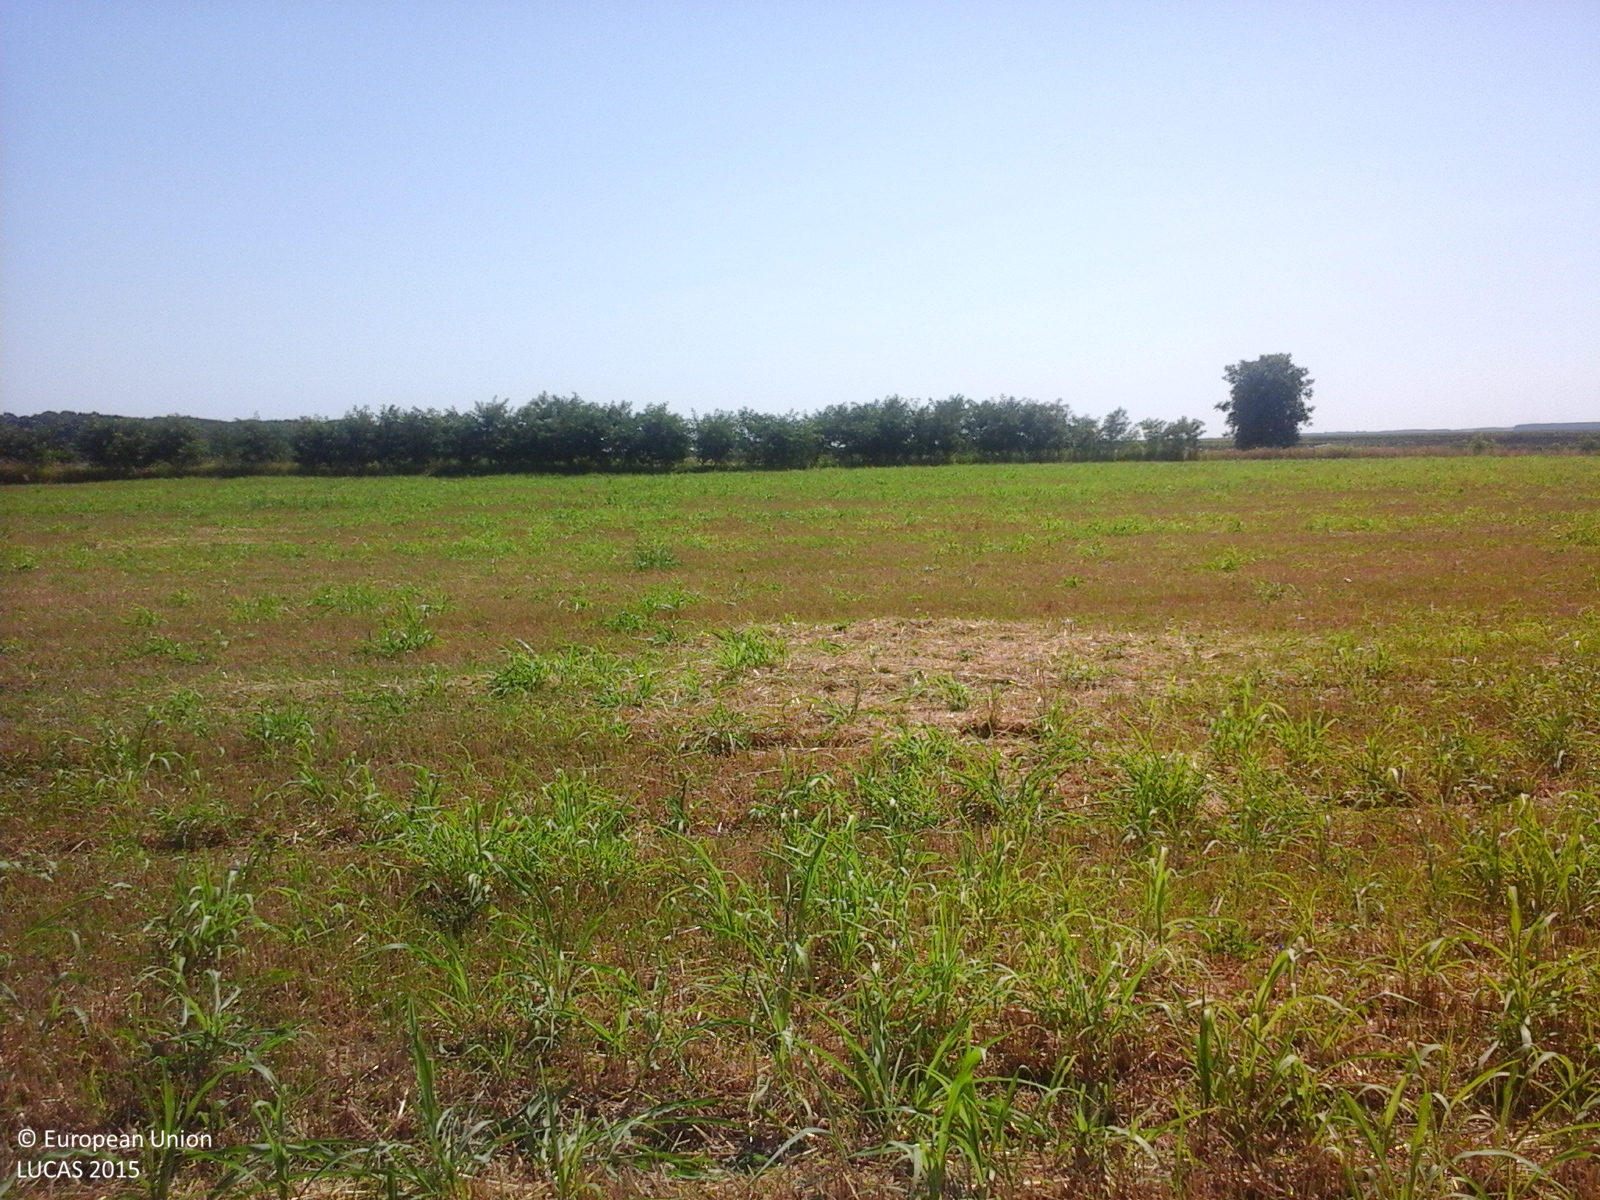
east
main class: Cropland
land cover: Common wheat
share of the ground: 50 - 75 %
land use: Agriculture (excluding fallow land and kitchen gardens)
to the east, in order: Common wheat; Abandoned hedges; Other bare soil
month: July
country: RO
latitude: 44.3797
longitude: 26.4935
